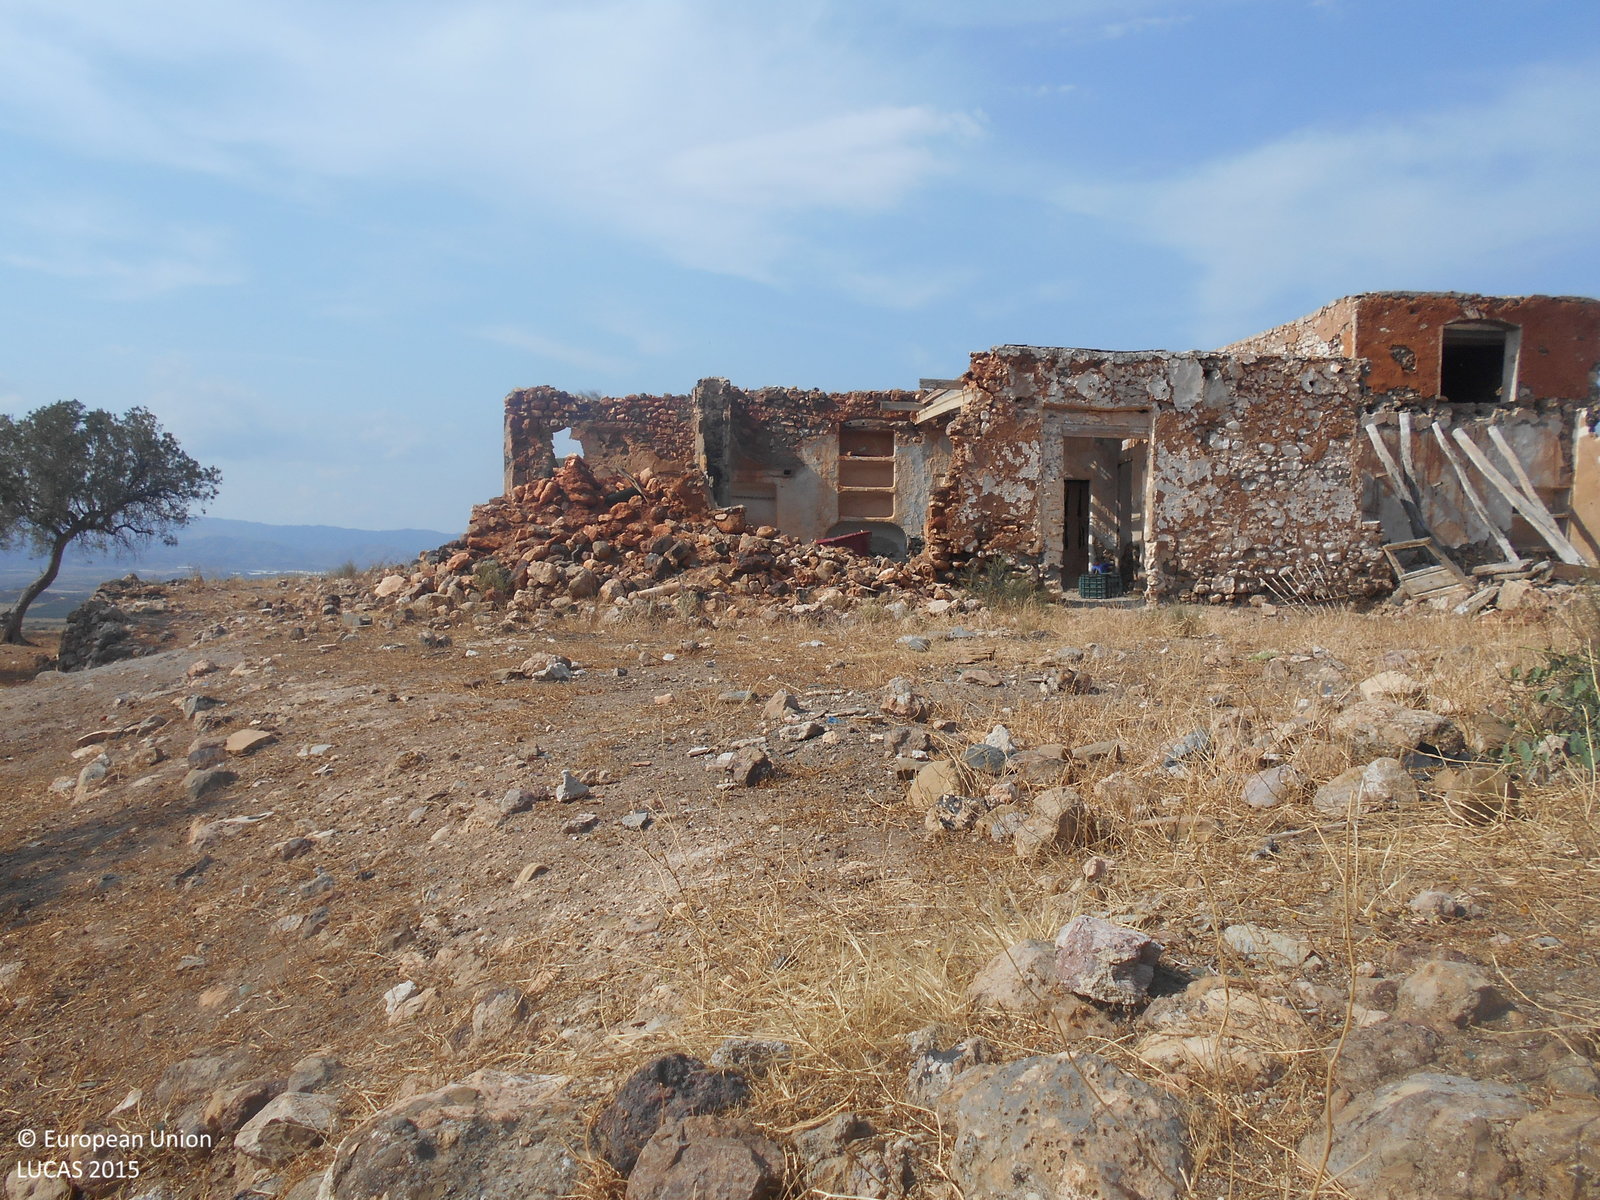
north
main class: Shrubland
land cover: Shrubland with sparse tree cover
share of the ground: 10 - 25 %
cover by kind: herbaceous plants 40 %, unconsolidated bare surface 35 %, shrubs 20 %, broadleaved forest trees 5 %
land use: Semi-natural and natural areas not in use
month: May
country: ES
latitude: 37.0448
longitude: -2.2437
